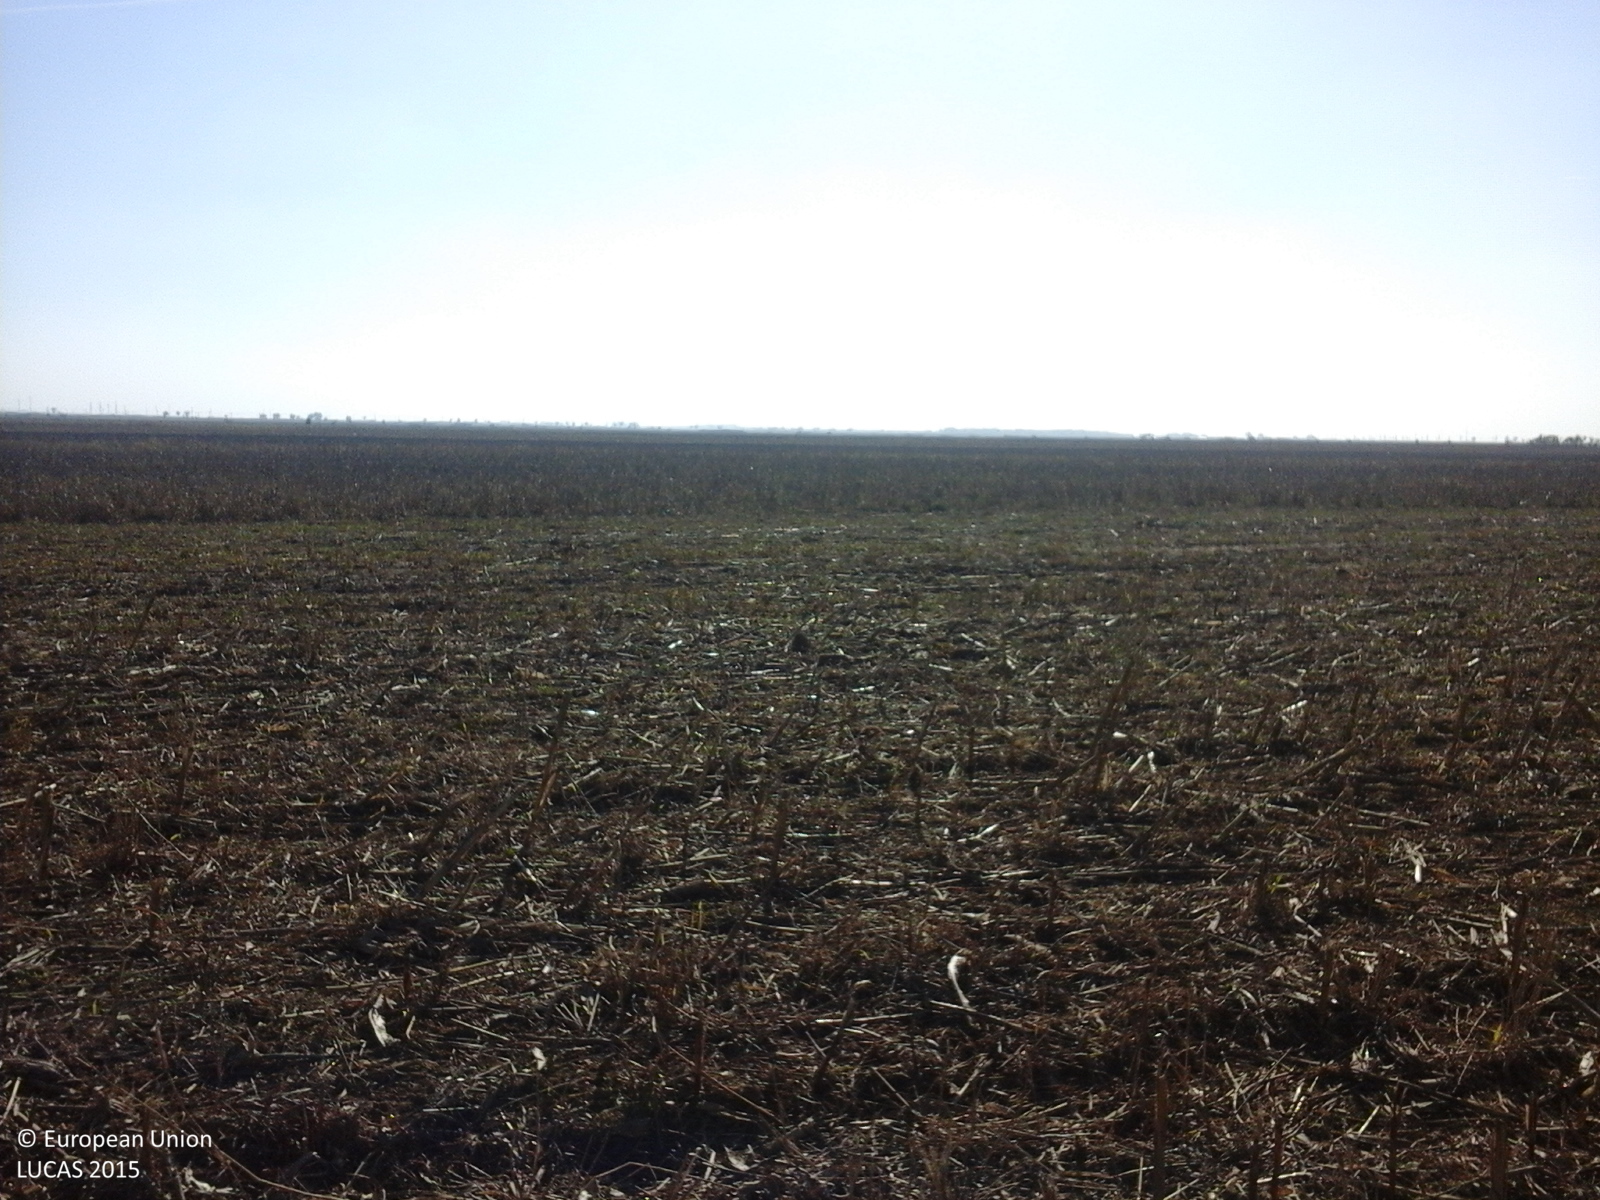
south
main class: Cropland
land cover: Maize
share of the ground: < 10 %
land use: Agriculture (excluding fallow land and kitchen gardens)
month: October
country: RO
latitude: 45.1332
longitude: 26.7214
